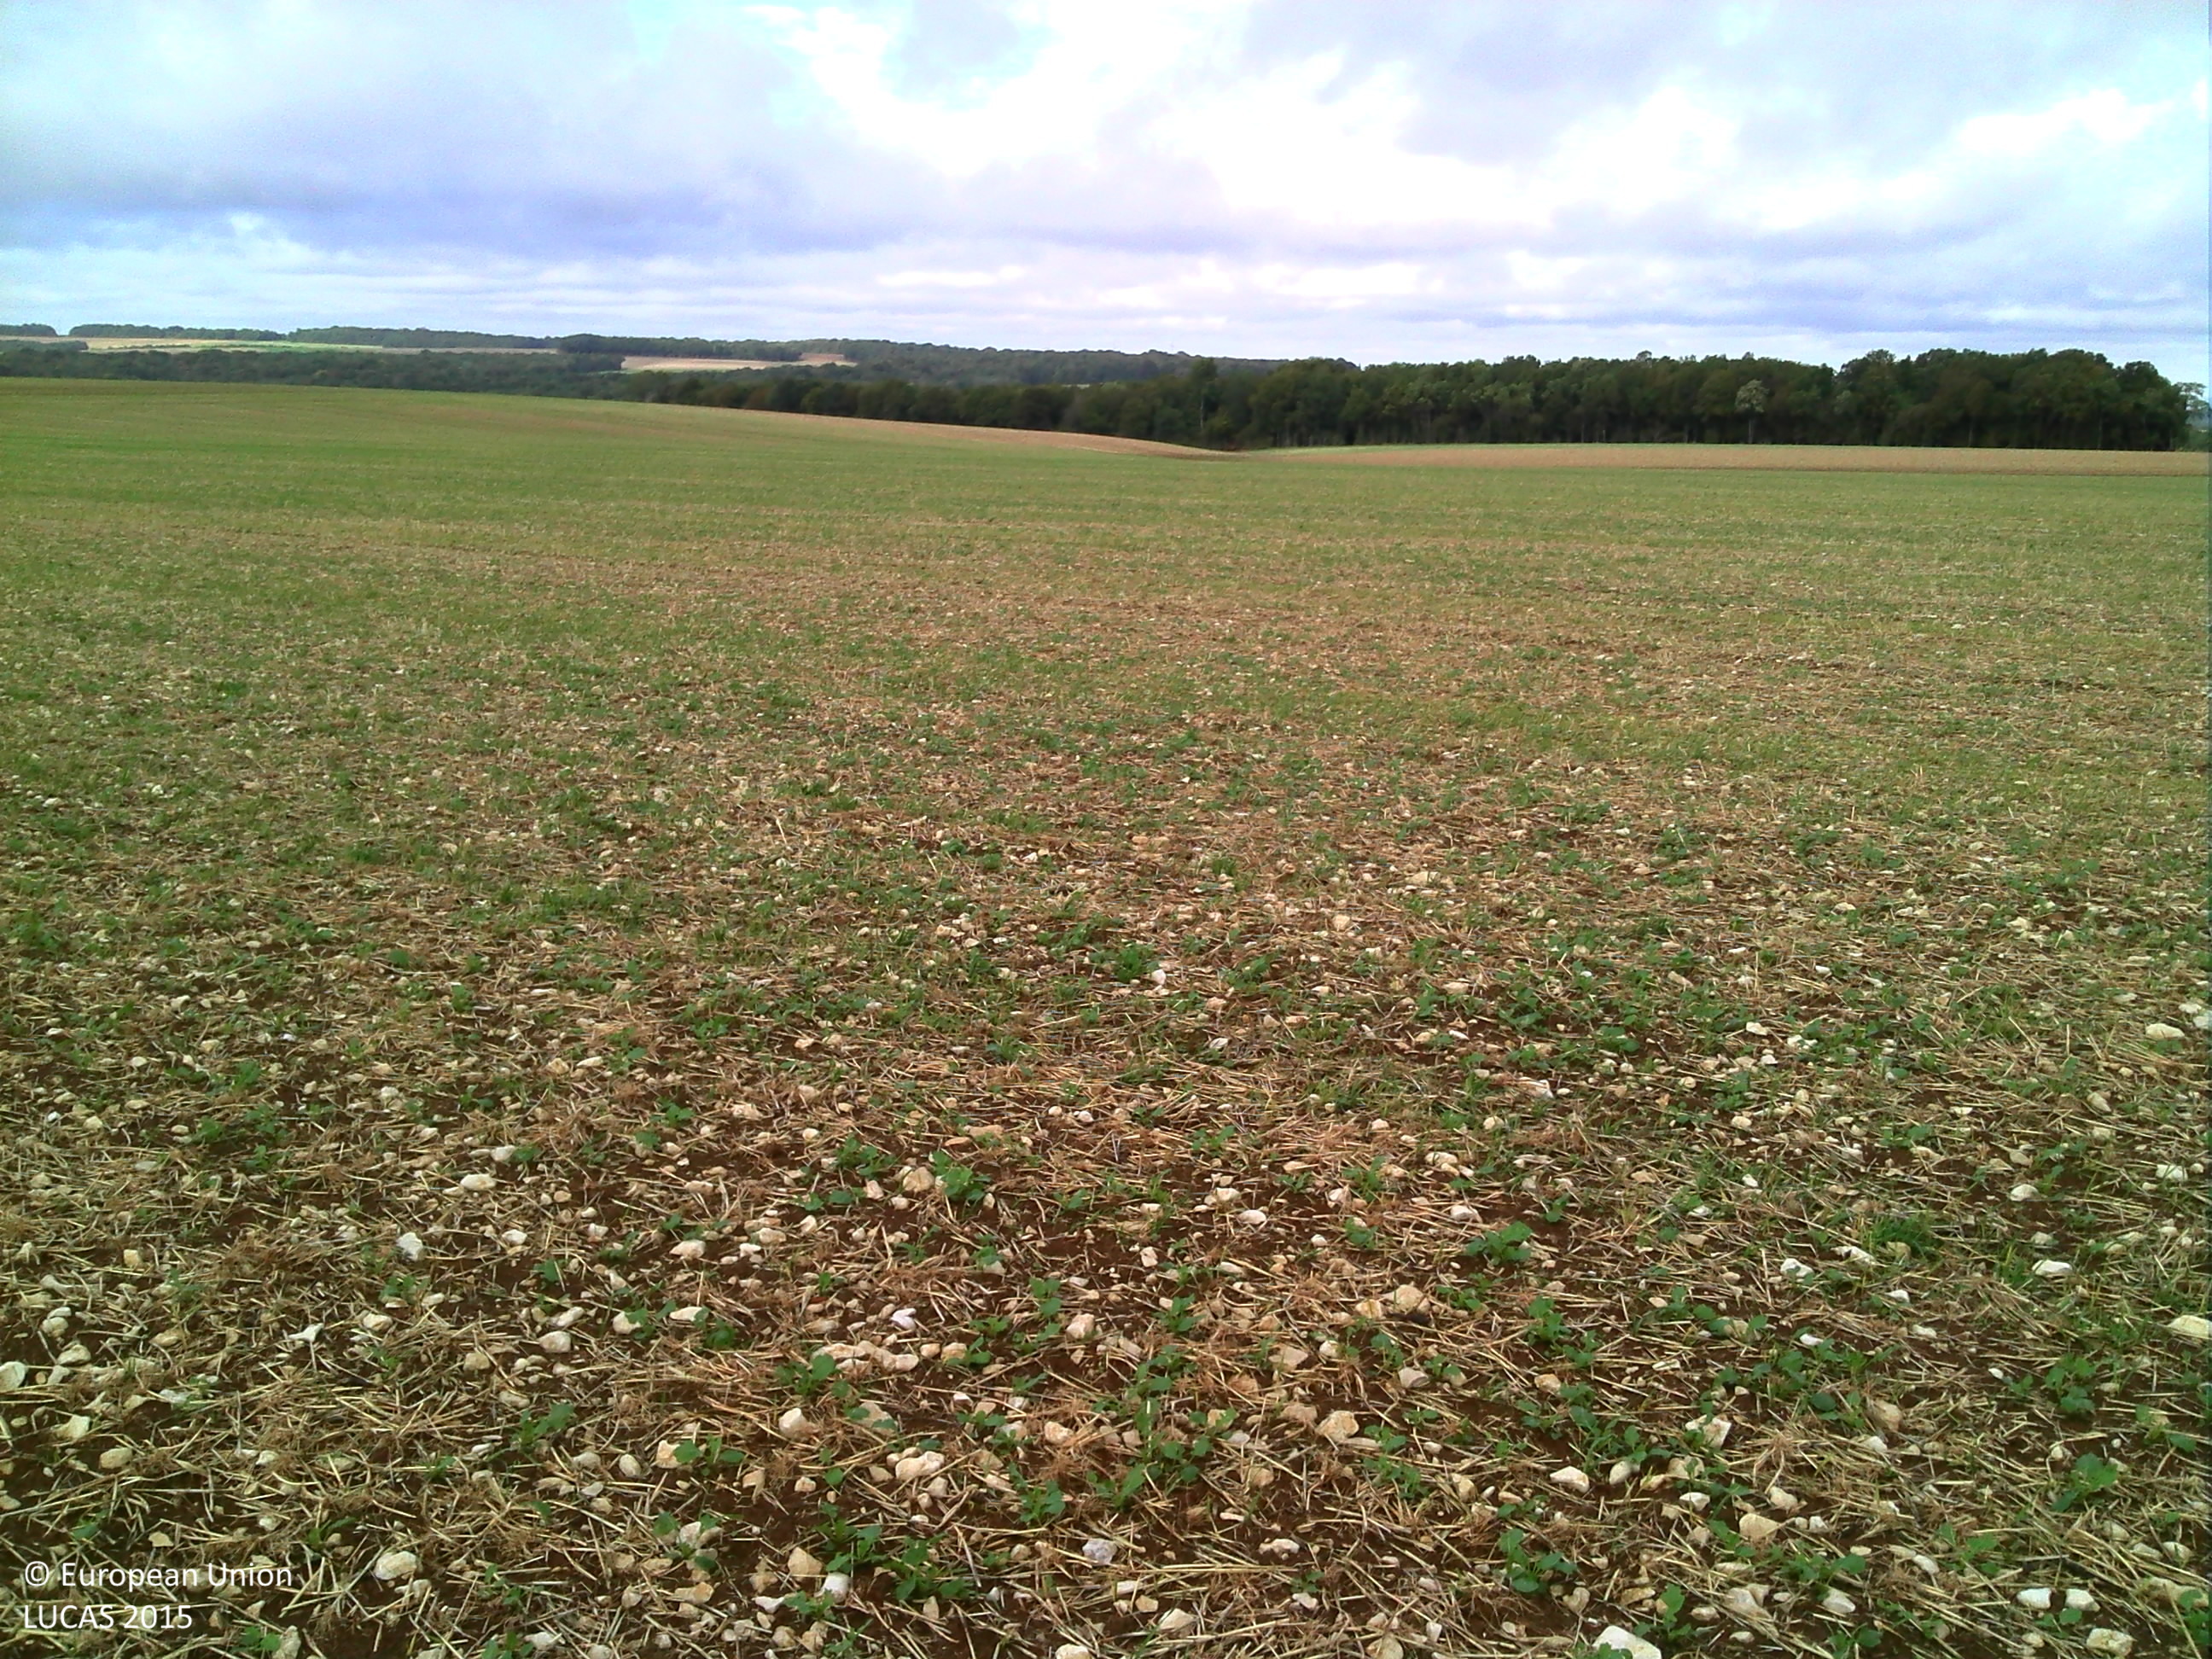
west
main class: Cropland
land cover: Rape and turnip rape
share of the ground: < 10 %
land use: Agriculture (excluding fallow land and kitchen gardens)
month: September
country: FR
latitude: 48.2804
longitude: 4.7832
